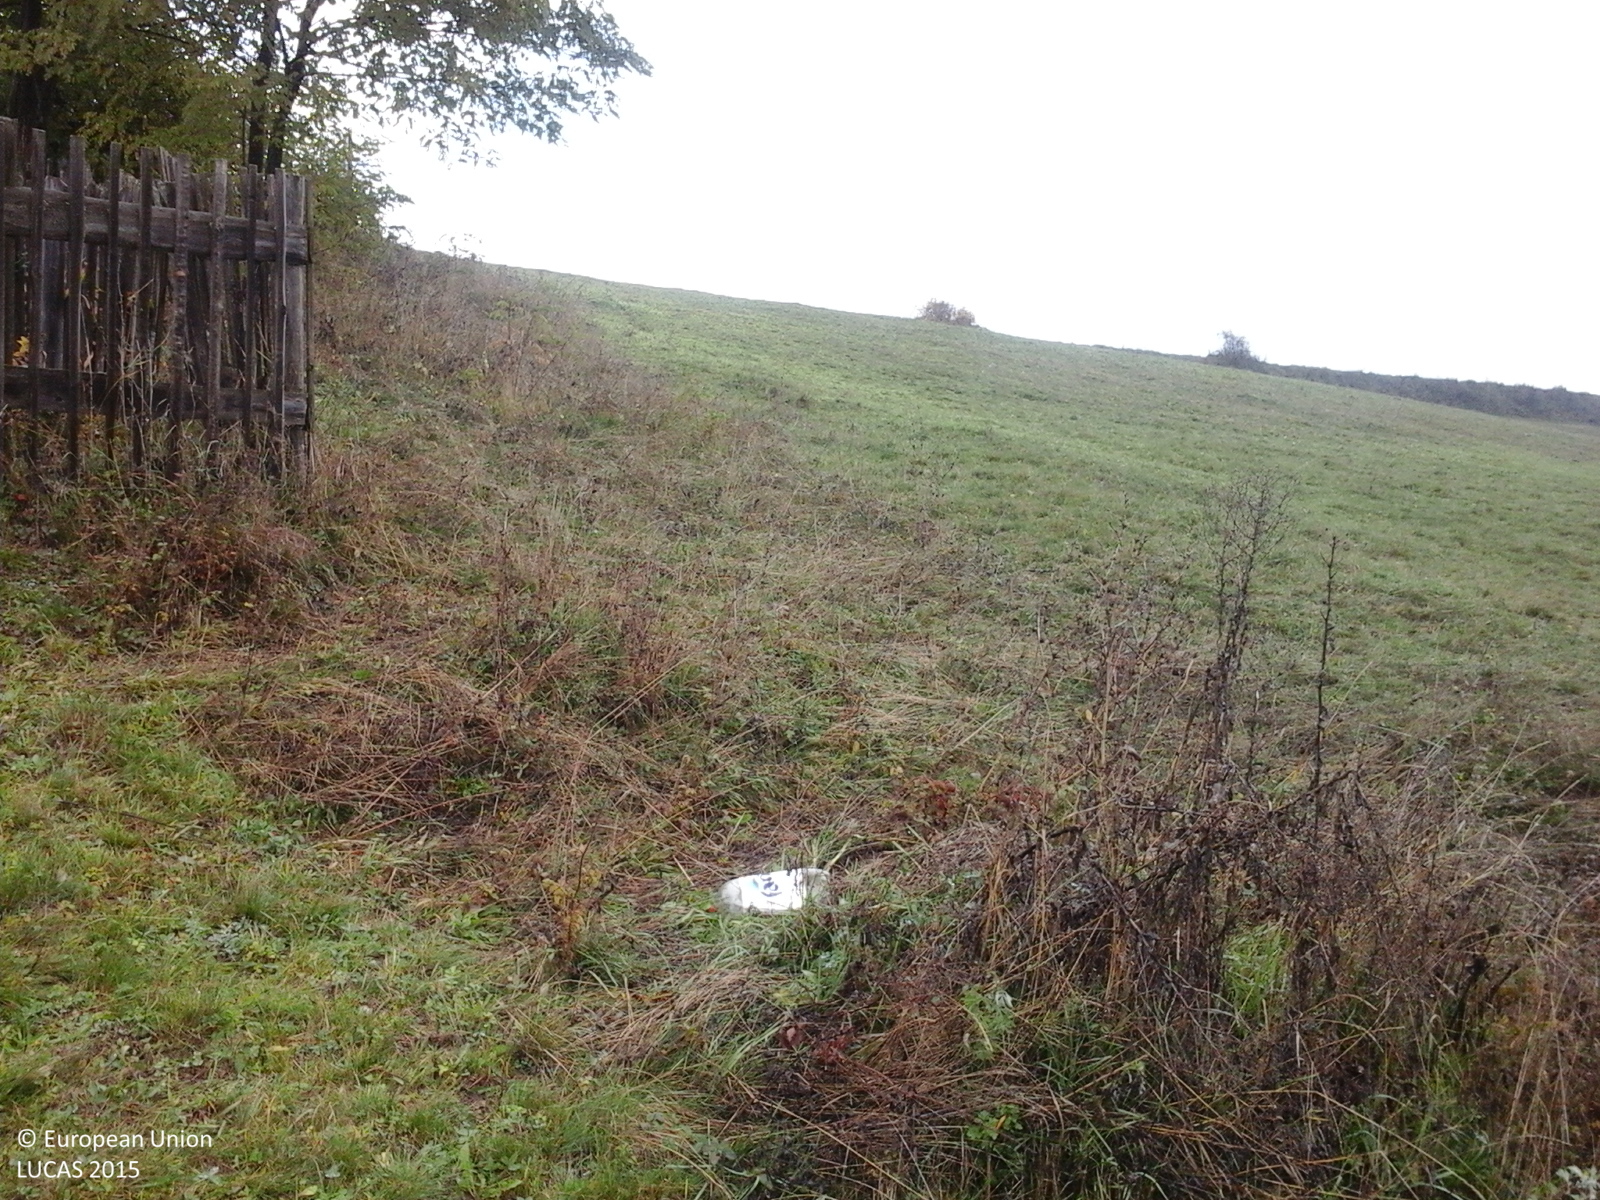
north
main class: Grassland
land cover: Grassland without tree/shrub cover
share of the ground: > 75 %
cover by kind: herbaceous plants 100 %
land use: Agriculture (excluding fallow land and kitchen gardens)
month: October
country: RO
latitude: 46.9373
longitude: 25.3594
